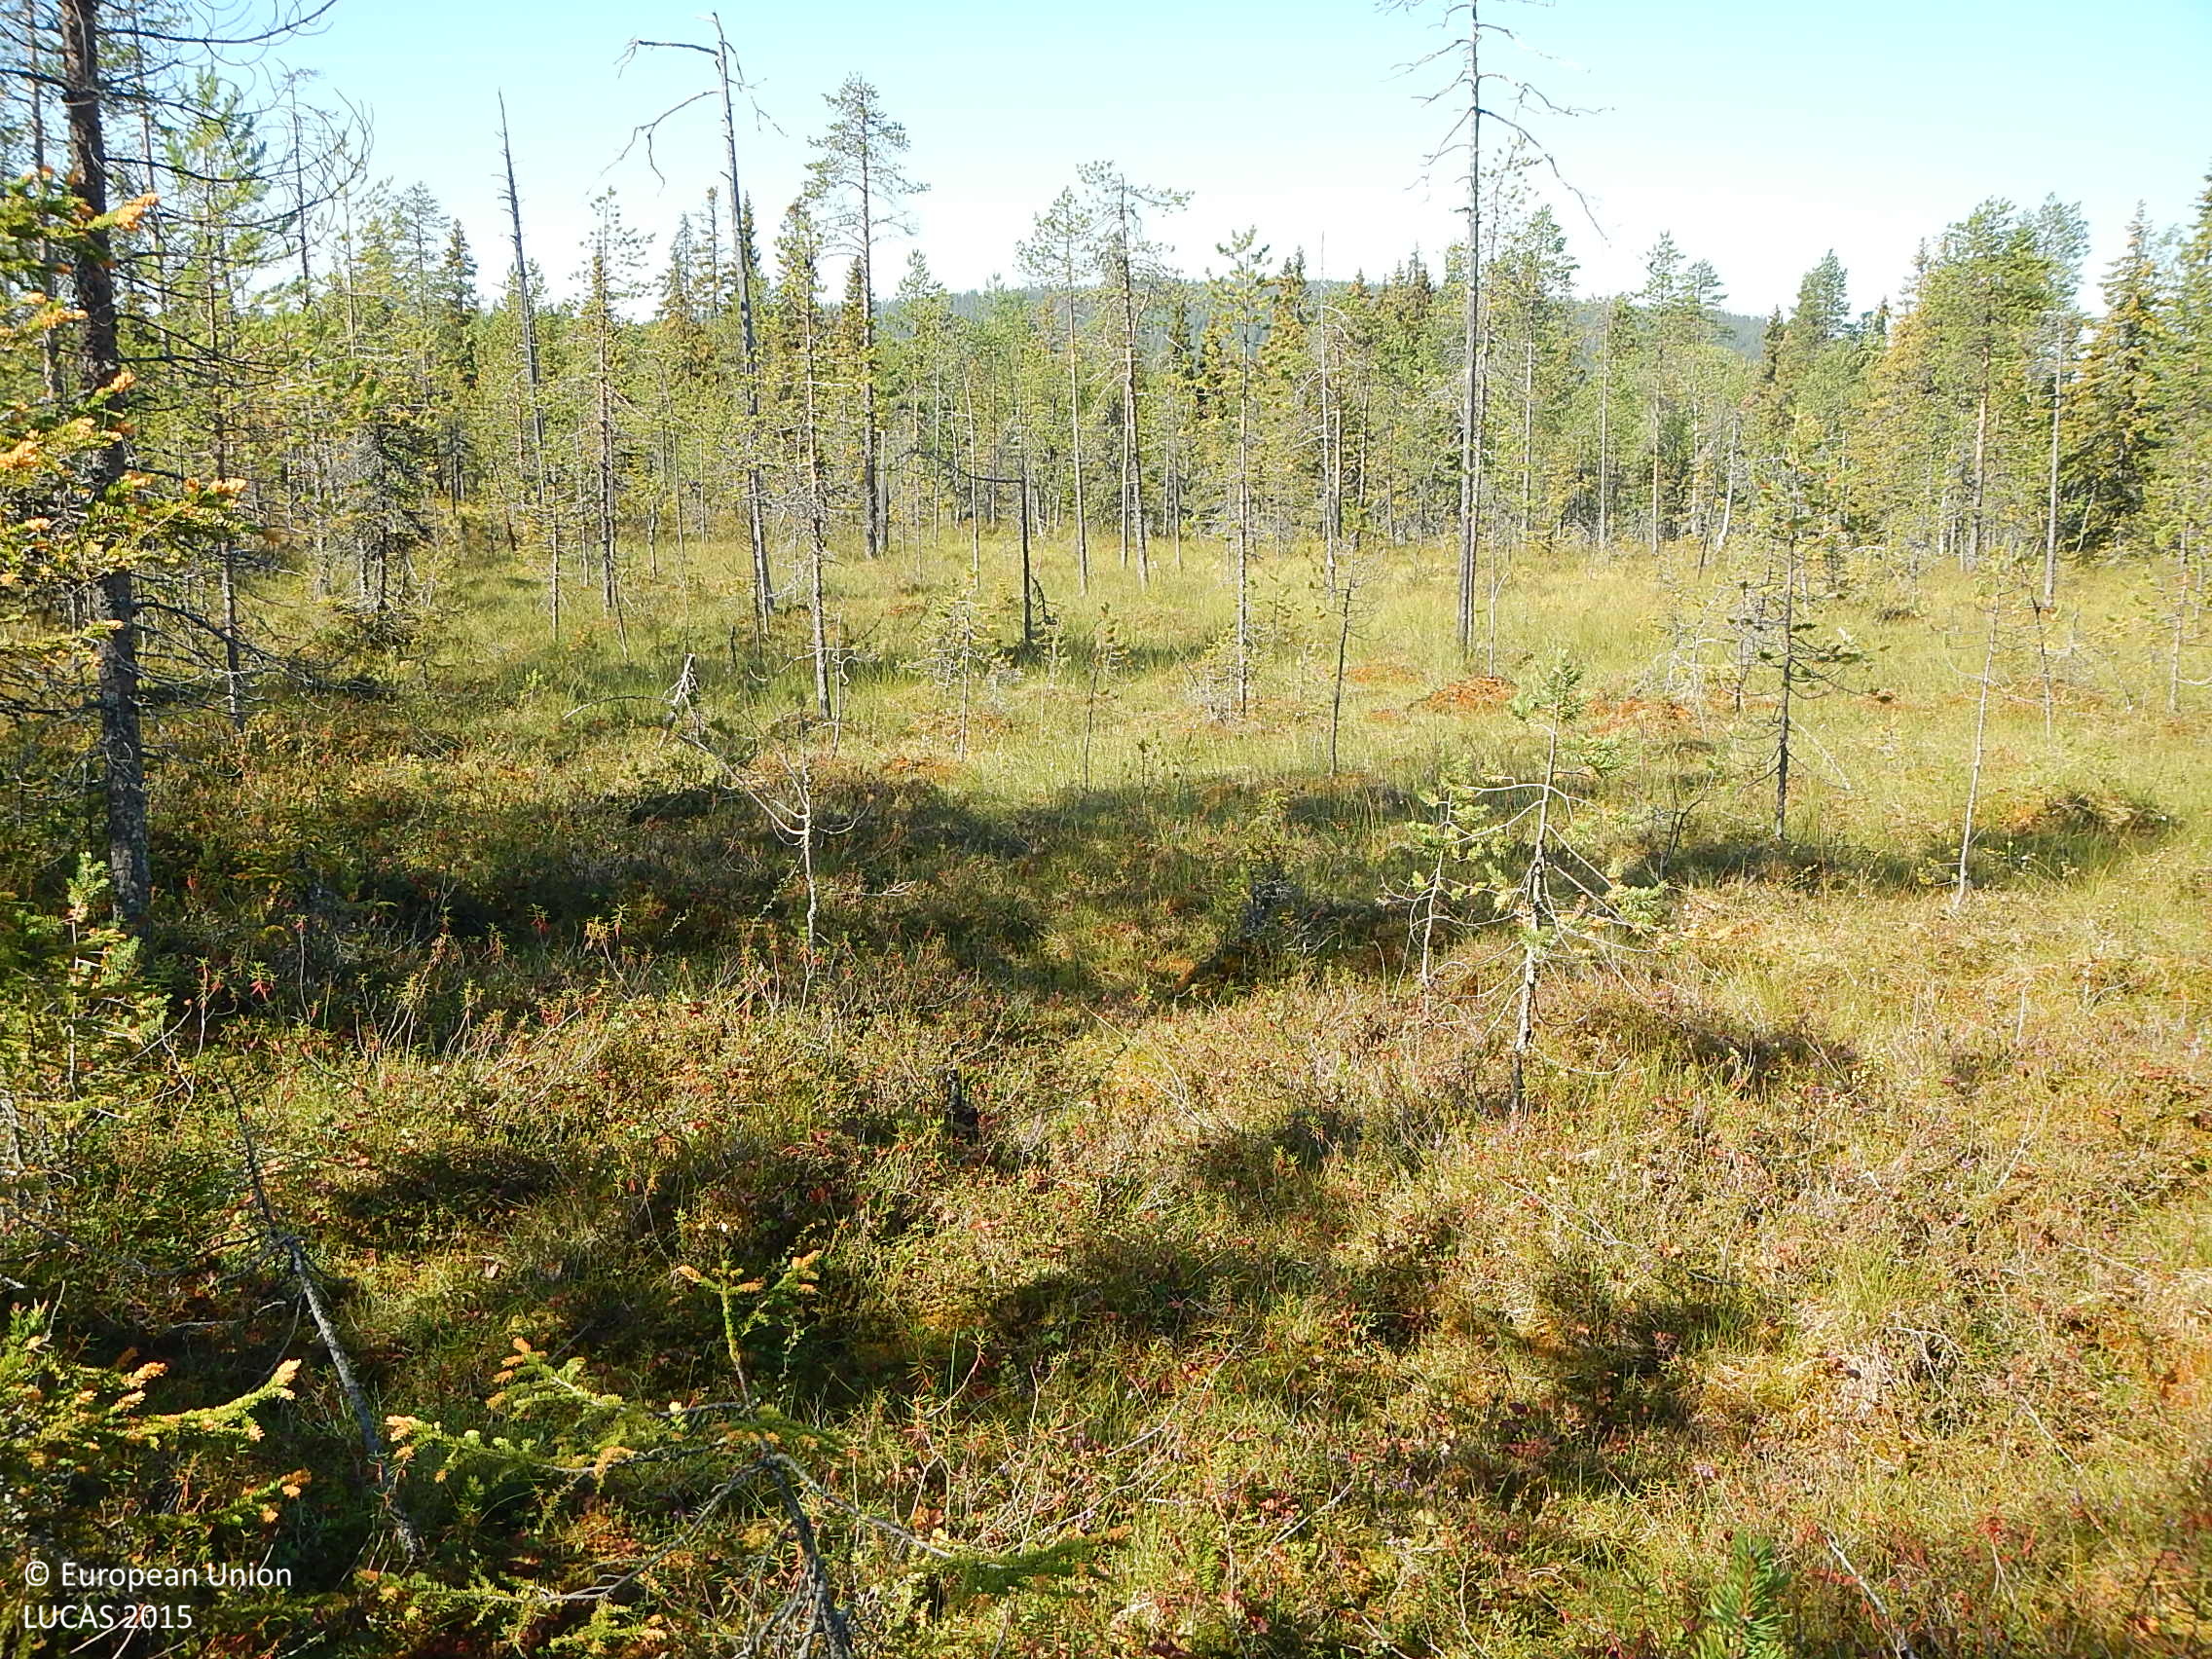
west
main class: Woodland
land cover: Other mixed woodland
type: boreal forest
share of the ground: 25 - 50 %
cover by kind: shrubs 40 %, lichens and mosses 20 %, coniferous forest trees 15 %, broadleaved forest trees 15 %, herbaceous plants 10 %
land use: Forestry
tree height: > 5 m
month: August
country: FI
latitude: 66.5257
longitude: 28.2007
